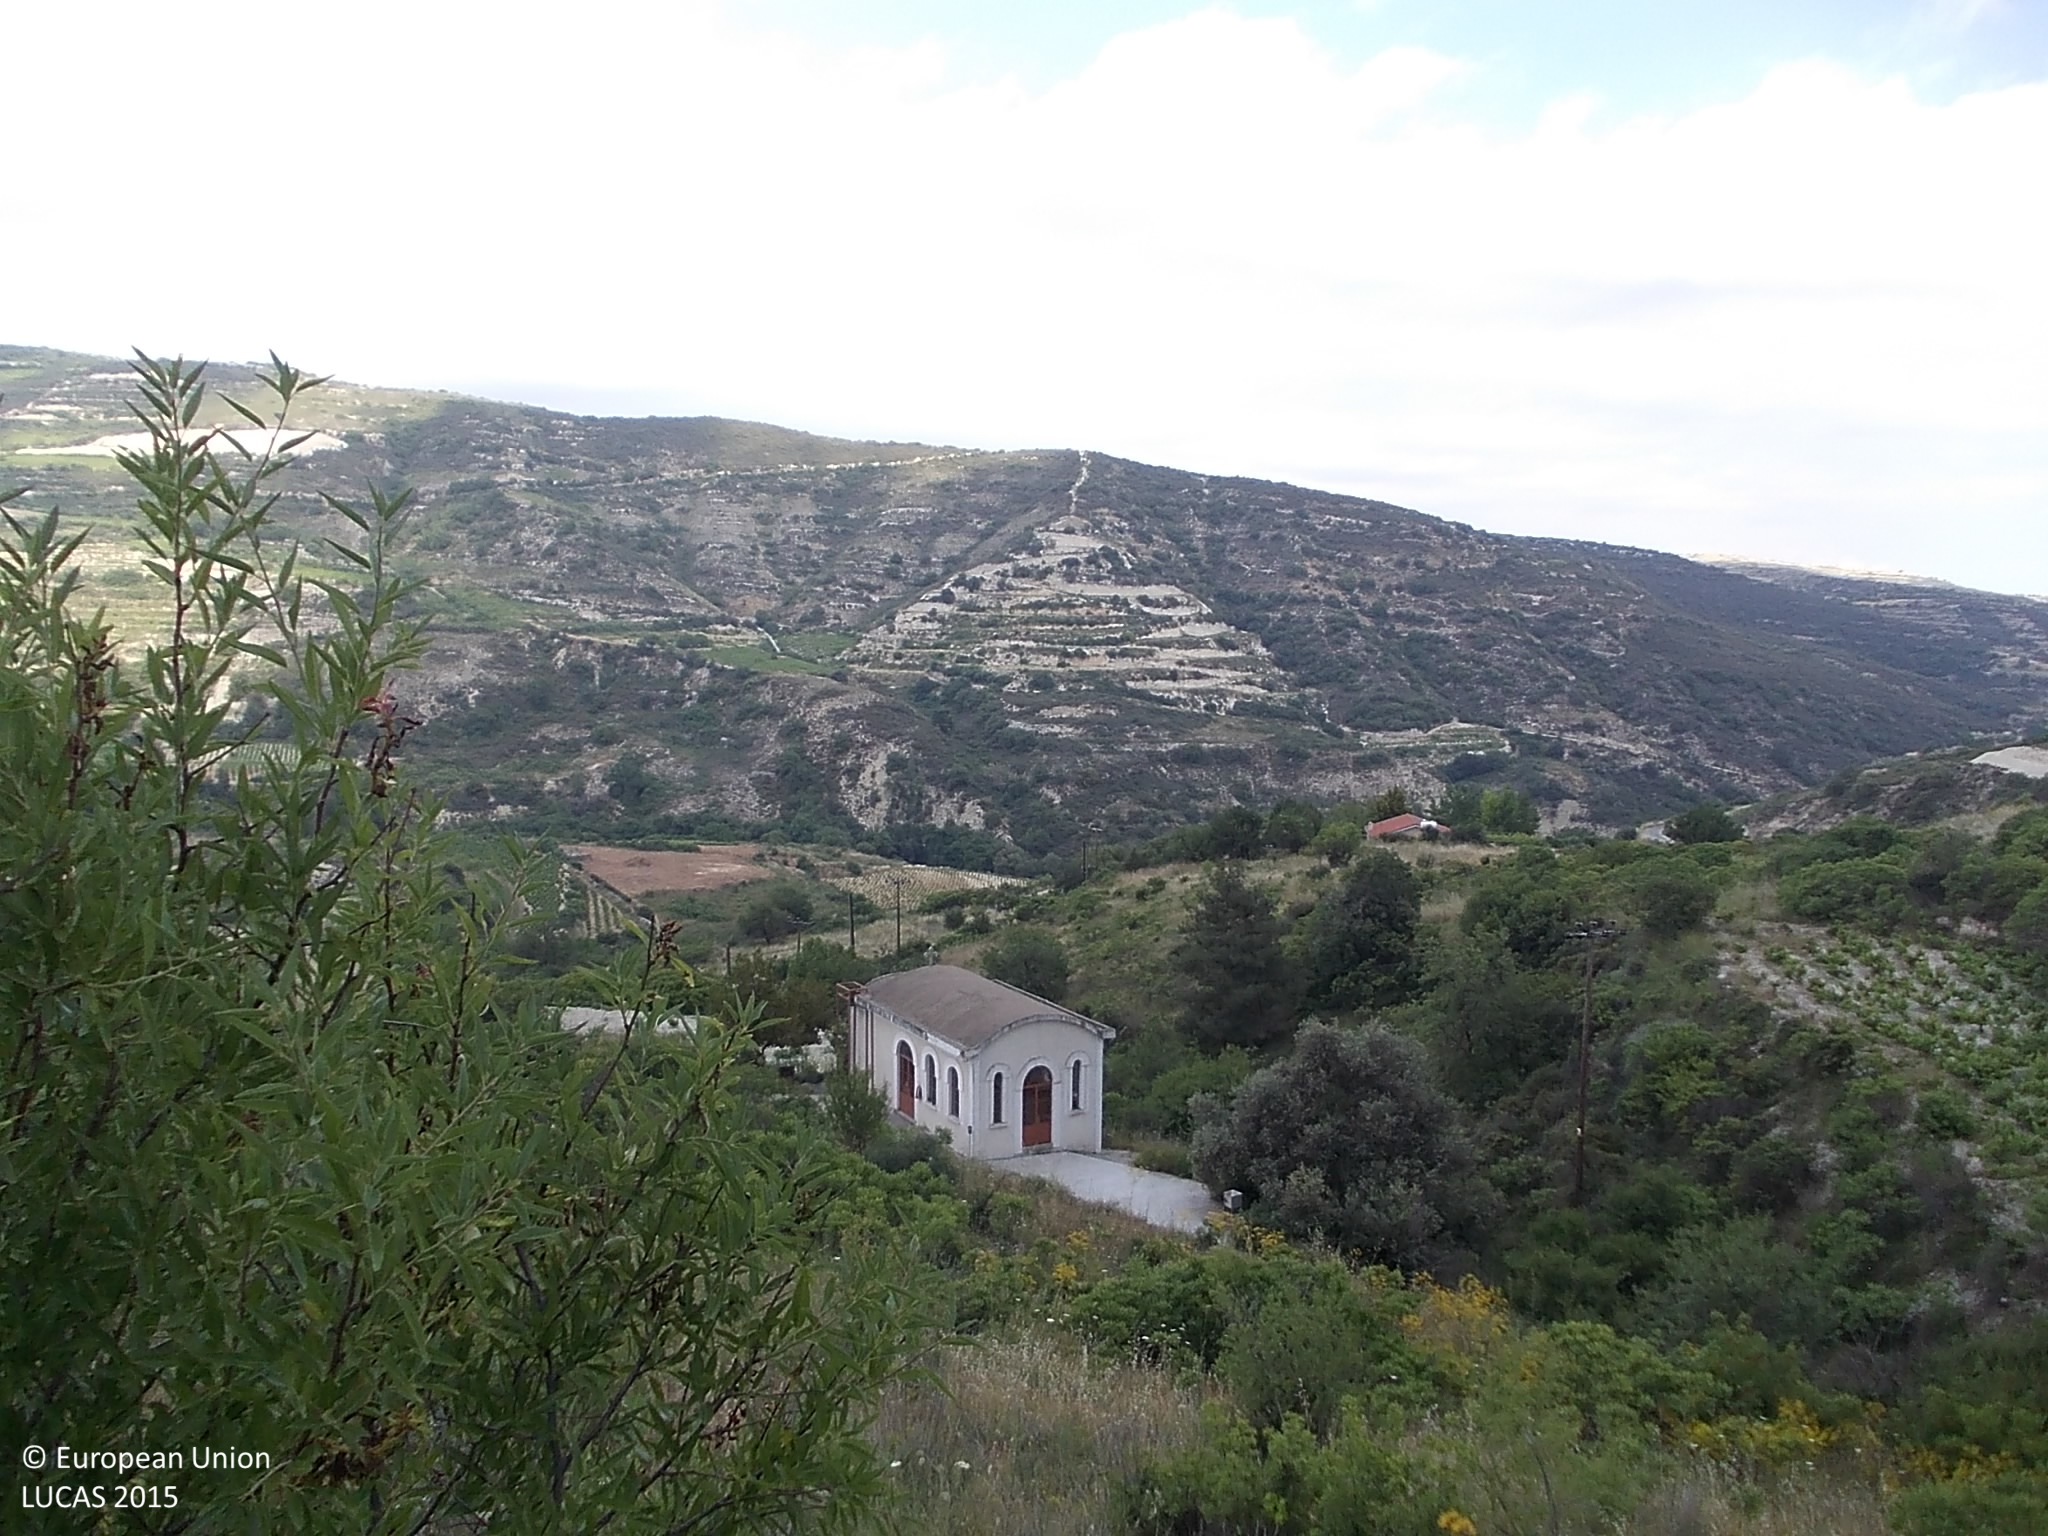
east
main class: Shrubland
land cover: Shrubland without tree cover
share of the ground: 10 - 25 %
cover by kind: herbaceous plants 75 %, shrubs 25 %
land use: Semi-natural and natural areas not in use
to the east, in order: Shrubland without tree cover; Grassland without tree/shrub cover; Tracks; Shrubland without tree cover; Vineyards; Shrubland with sparse tree cover; Vineyards; Other mixed woodland; Vineyards; Grassland without tree/shrub cover; Artificial constructions in urban areas; Shrubland without tree cover; Paved roads, cycling and walking lanes; Vineyards; Tracks; Vineyards; Abandoned hedges; Vineyards; Shrubland without tree cover; Vineyards
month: May
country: CY
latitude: 34.8425
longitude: 32.8094
